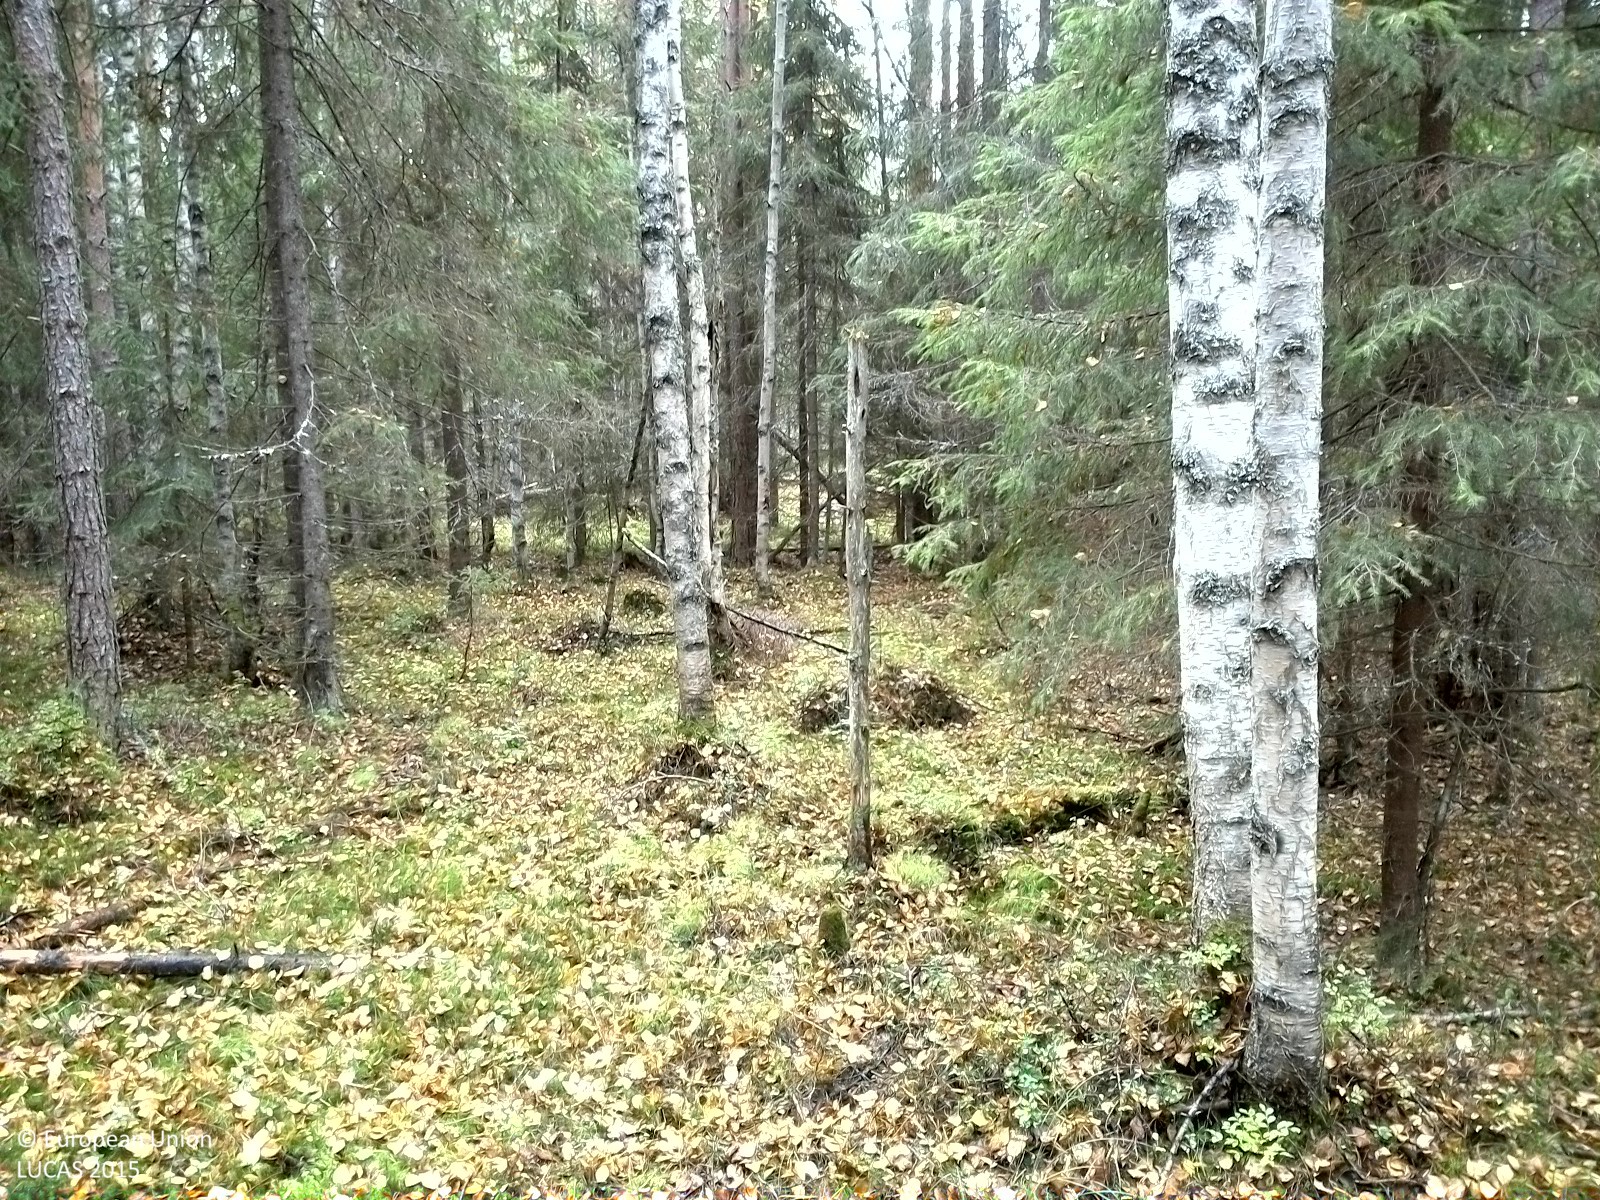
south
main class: Woodland
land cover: Other mixed woodland
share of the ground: > 75 %
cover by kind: coniferous forest trees 50 %, broadleaved forest trees 20 %, lichens and mosses 20 %, shrubs 10 %
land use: Forestry
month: October
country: SE
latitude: 62.5321
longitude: 17.5397
